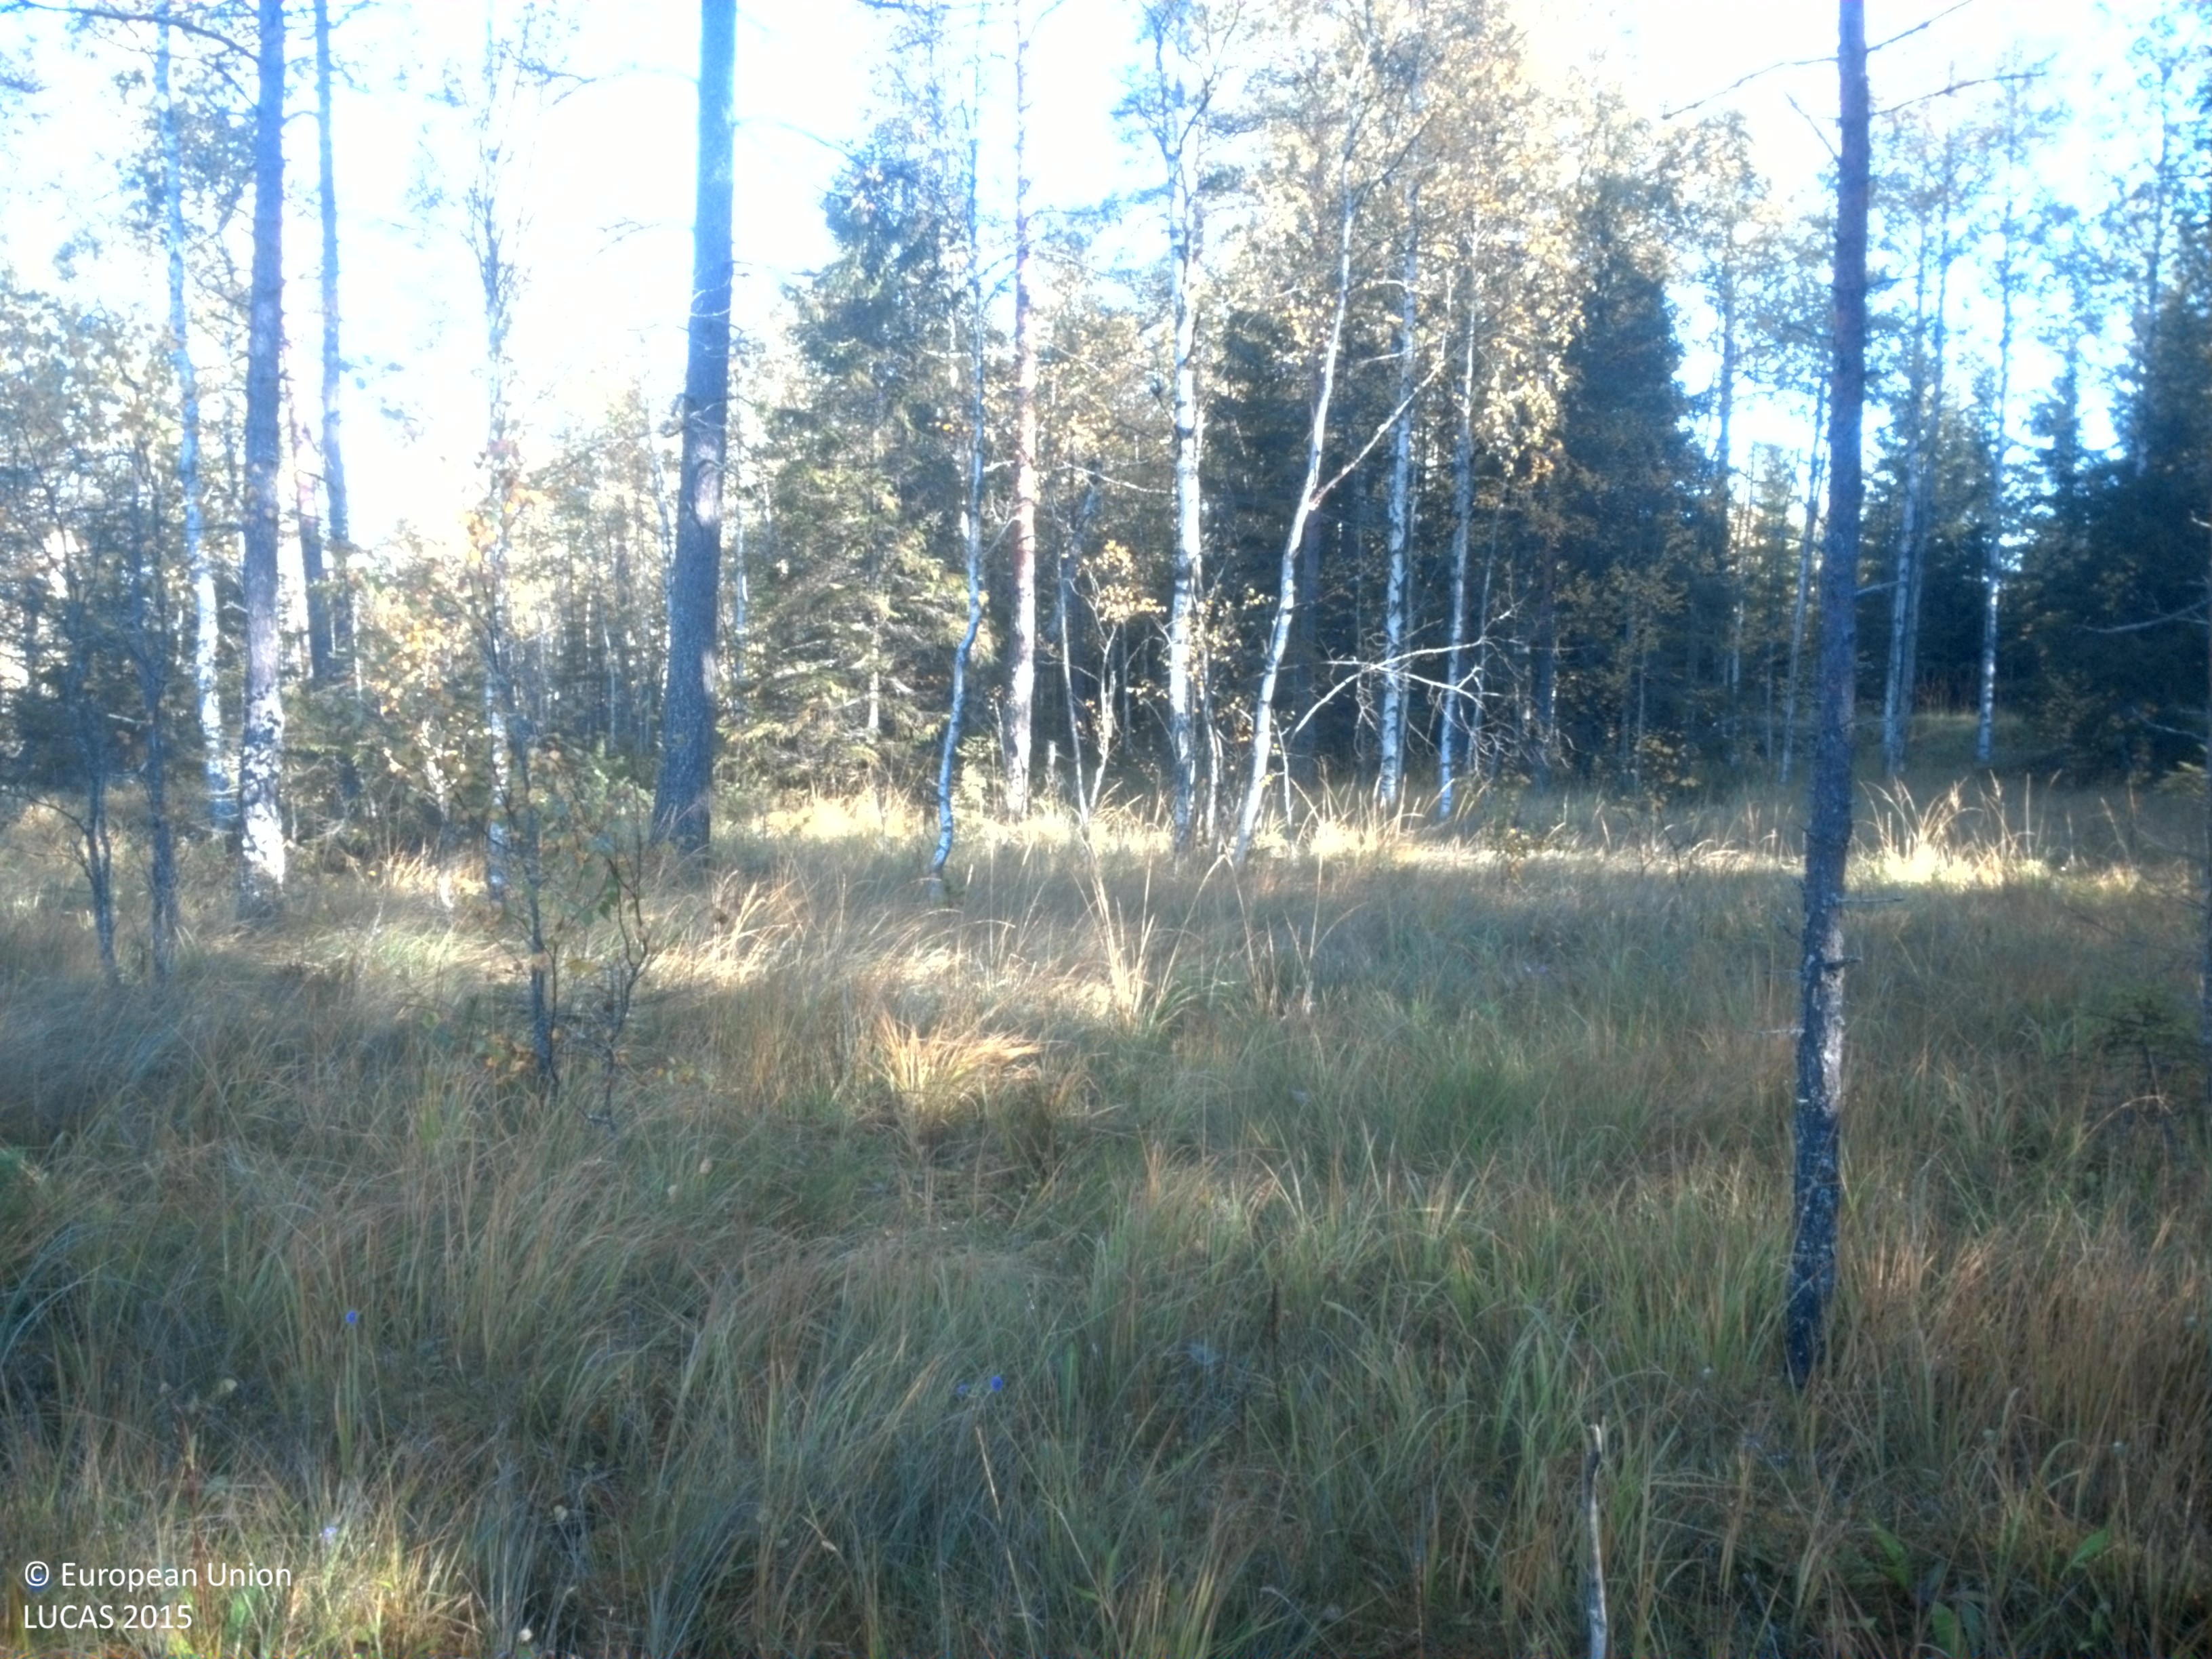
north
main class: Woodland
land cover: Other mixed woodland
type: mire and swamp forests
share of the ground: 50 - 75 %
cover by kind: coniferous forest trees 45 %, broadleaved forest trees 15 %, herbaceous plants 15 %, lichens and mosses 15 %, shrubs 10 %
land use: Forestry
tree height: > 5 m
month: September
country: SE
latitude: 59.9047
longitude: 15.1924
